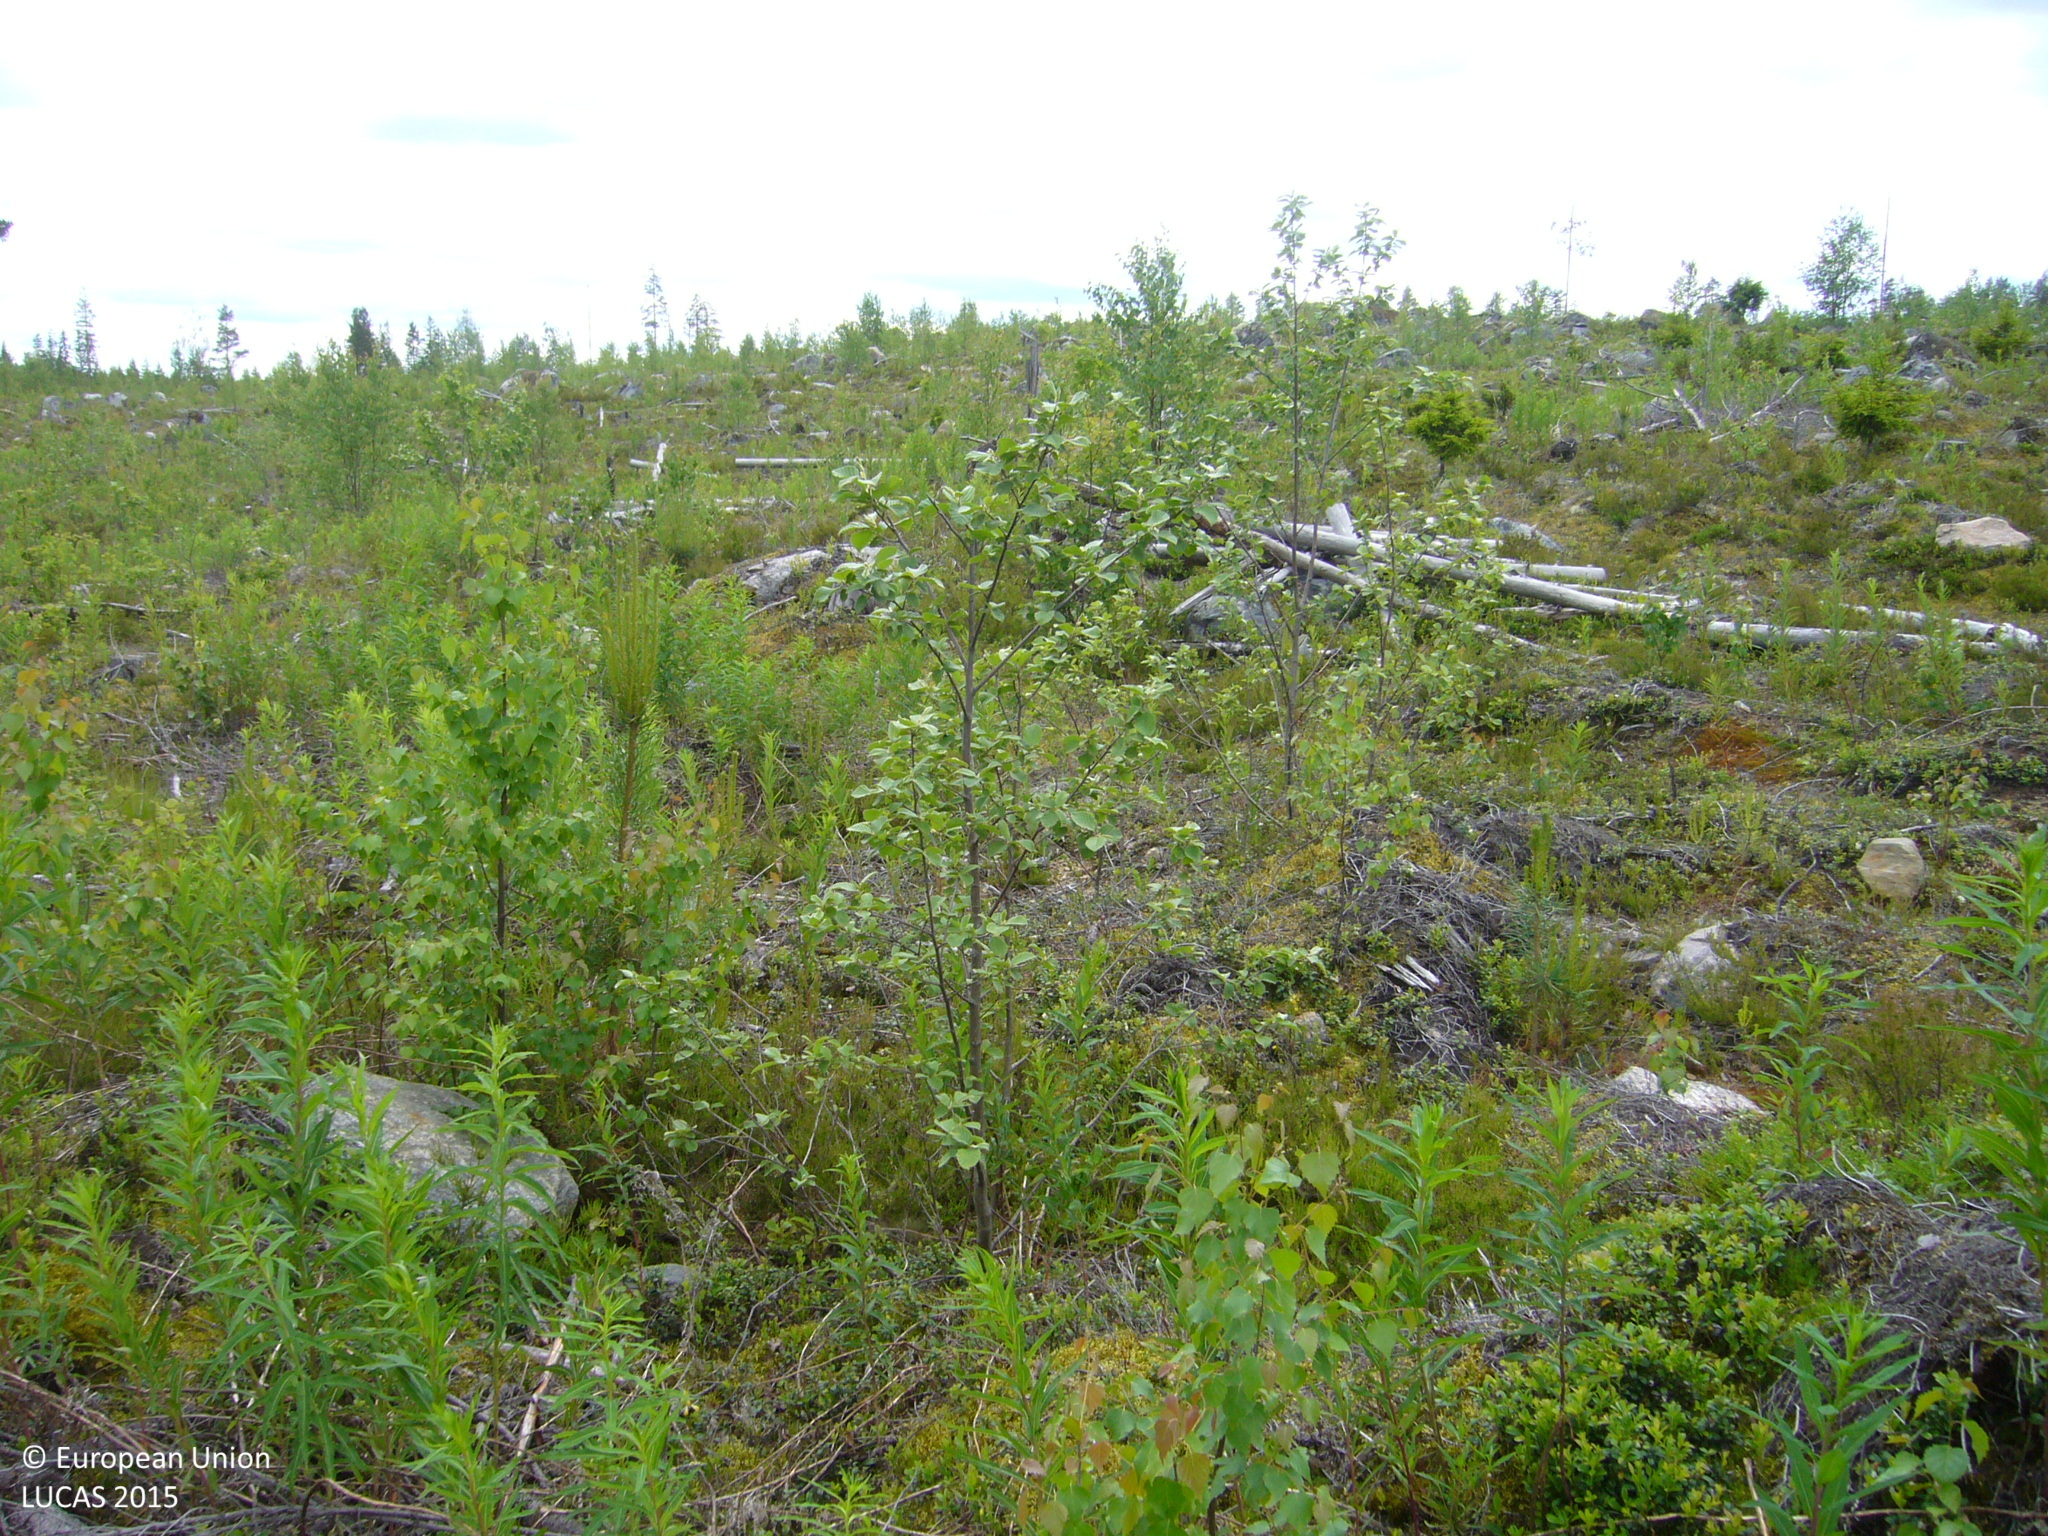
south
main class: Shrubland
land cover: Shrubland with sparse tree cover
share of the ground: > 75 %
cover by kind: shrubs 85 %, broadleaved forest trees 5 %
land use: Forestry
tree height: < 5 m
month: July
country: FI
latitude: 63.4133
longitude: 26.1604
